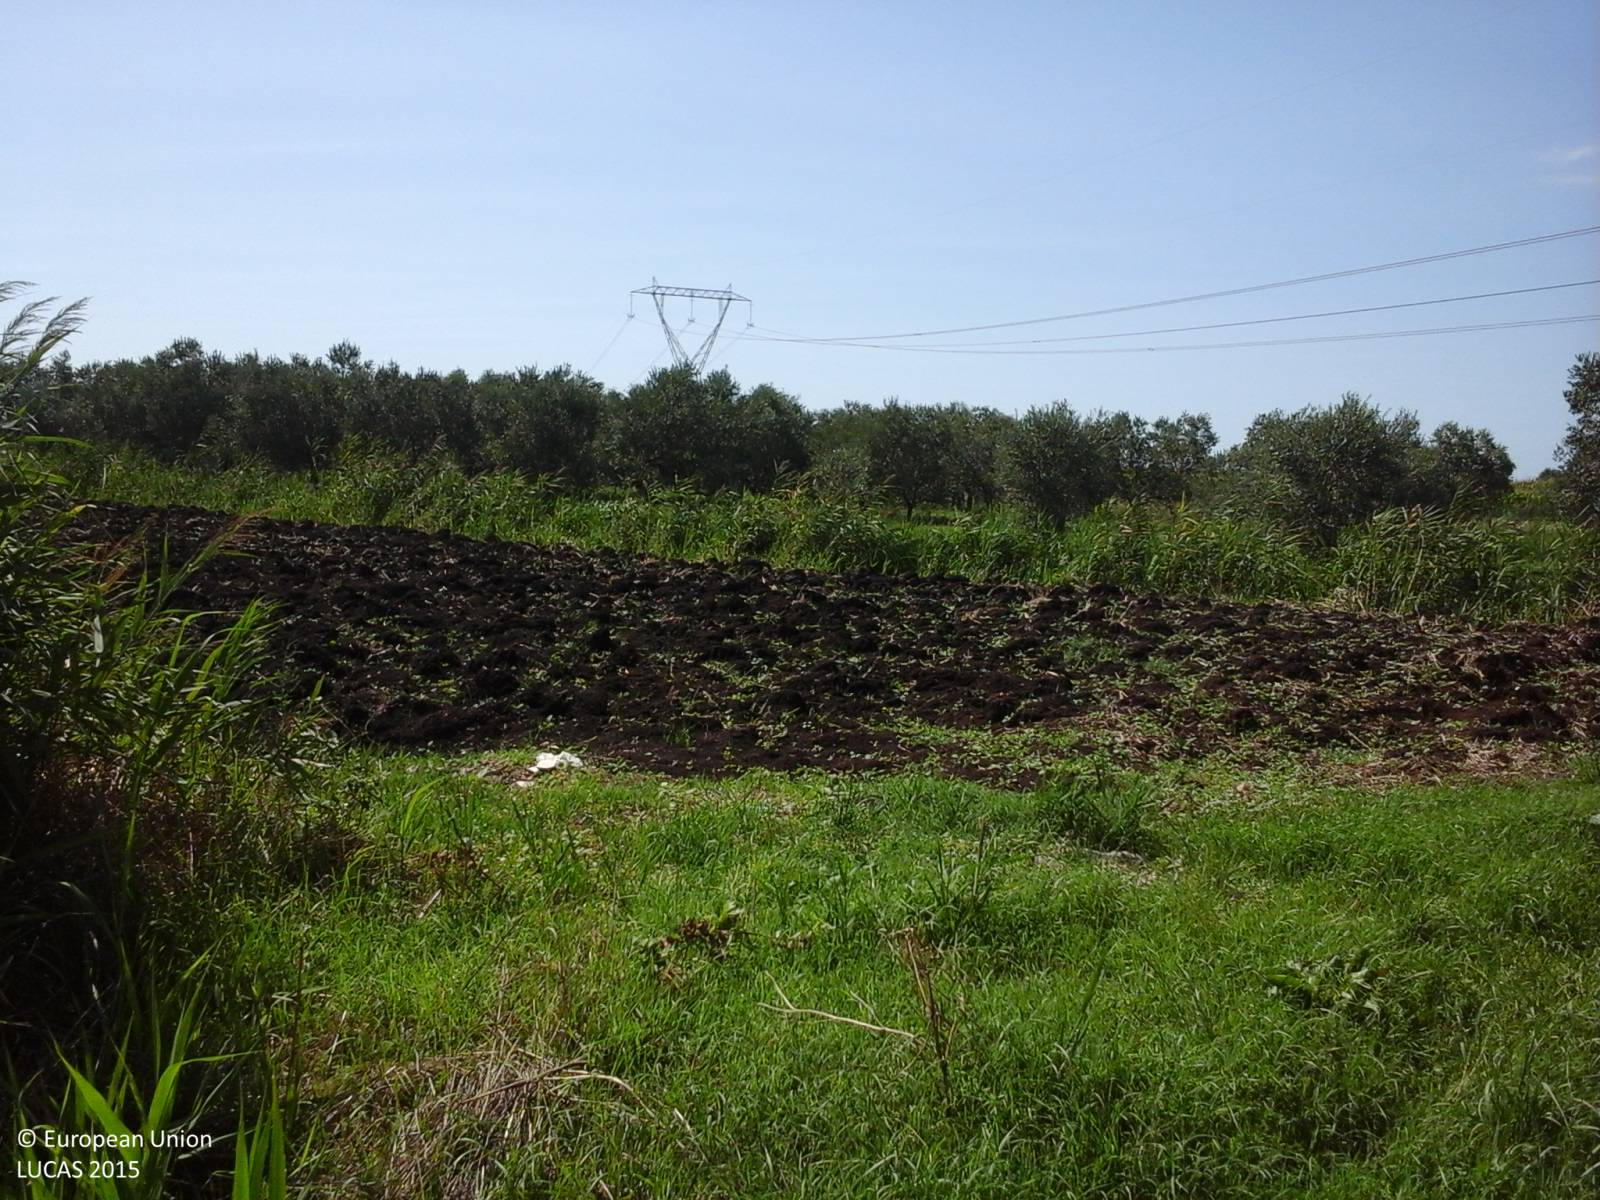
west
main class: Cropland
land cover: Maize
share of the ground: > 75 %
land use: Agriculture (excluding fallow land and kitchen gardens)
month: August
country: IT
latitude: 41.4685
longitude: 13.0651
